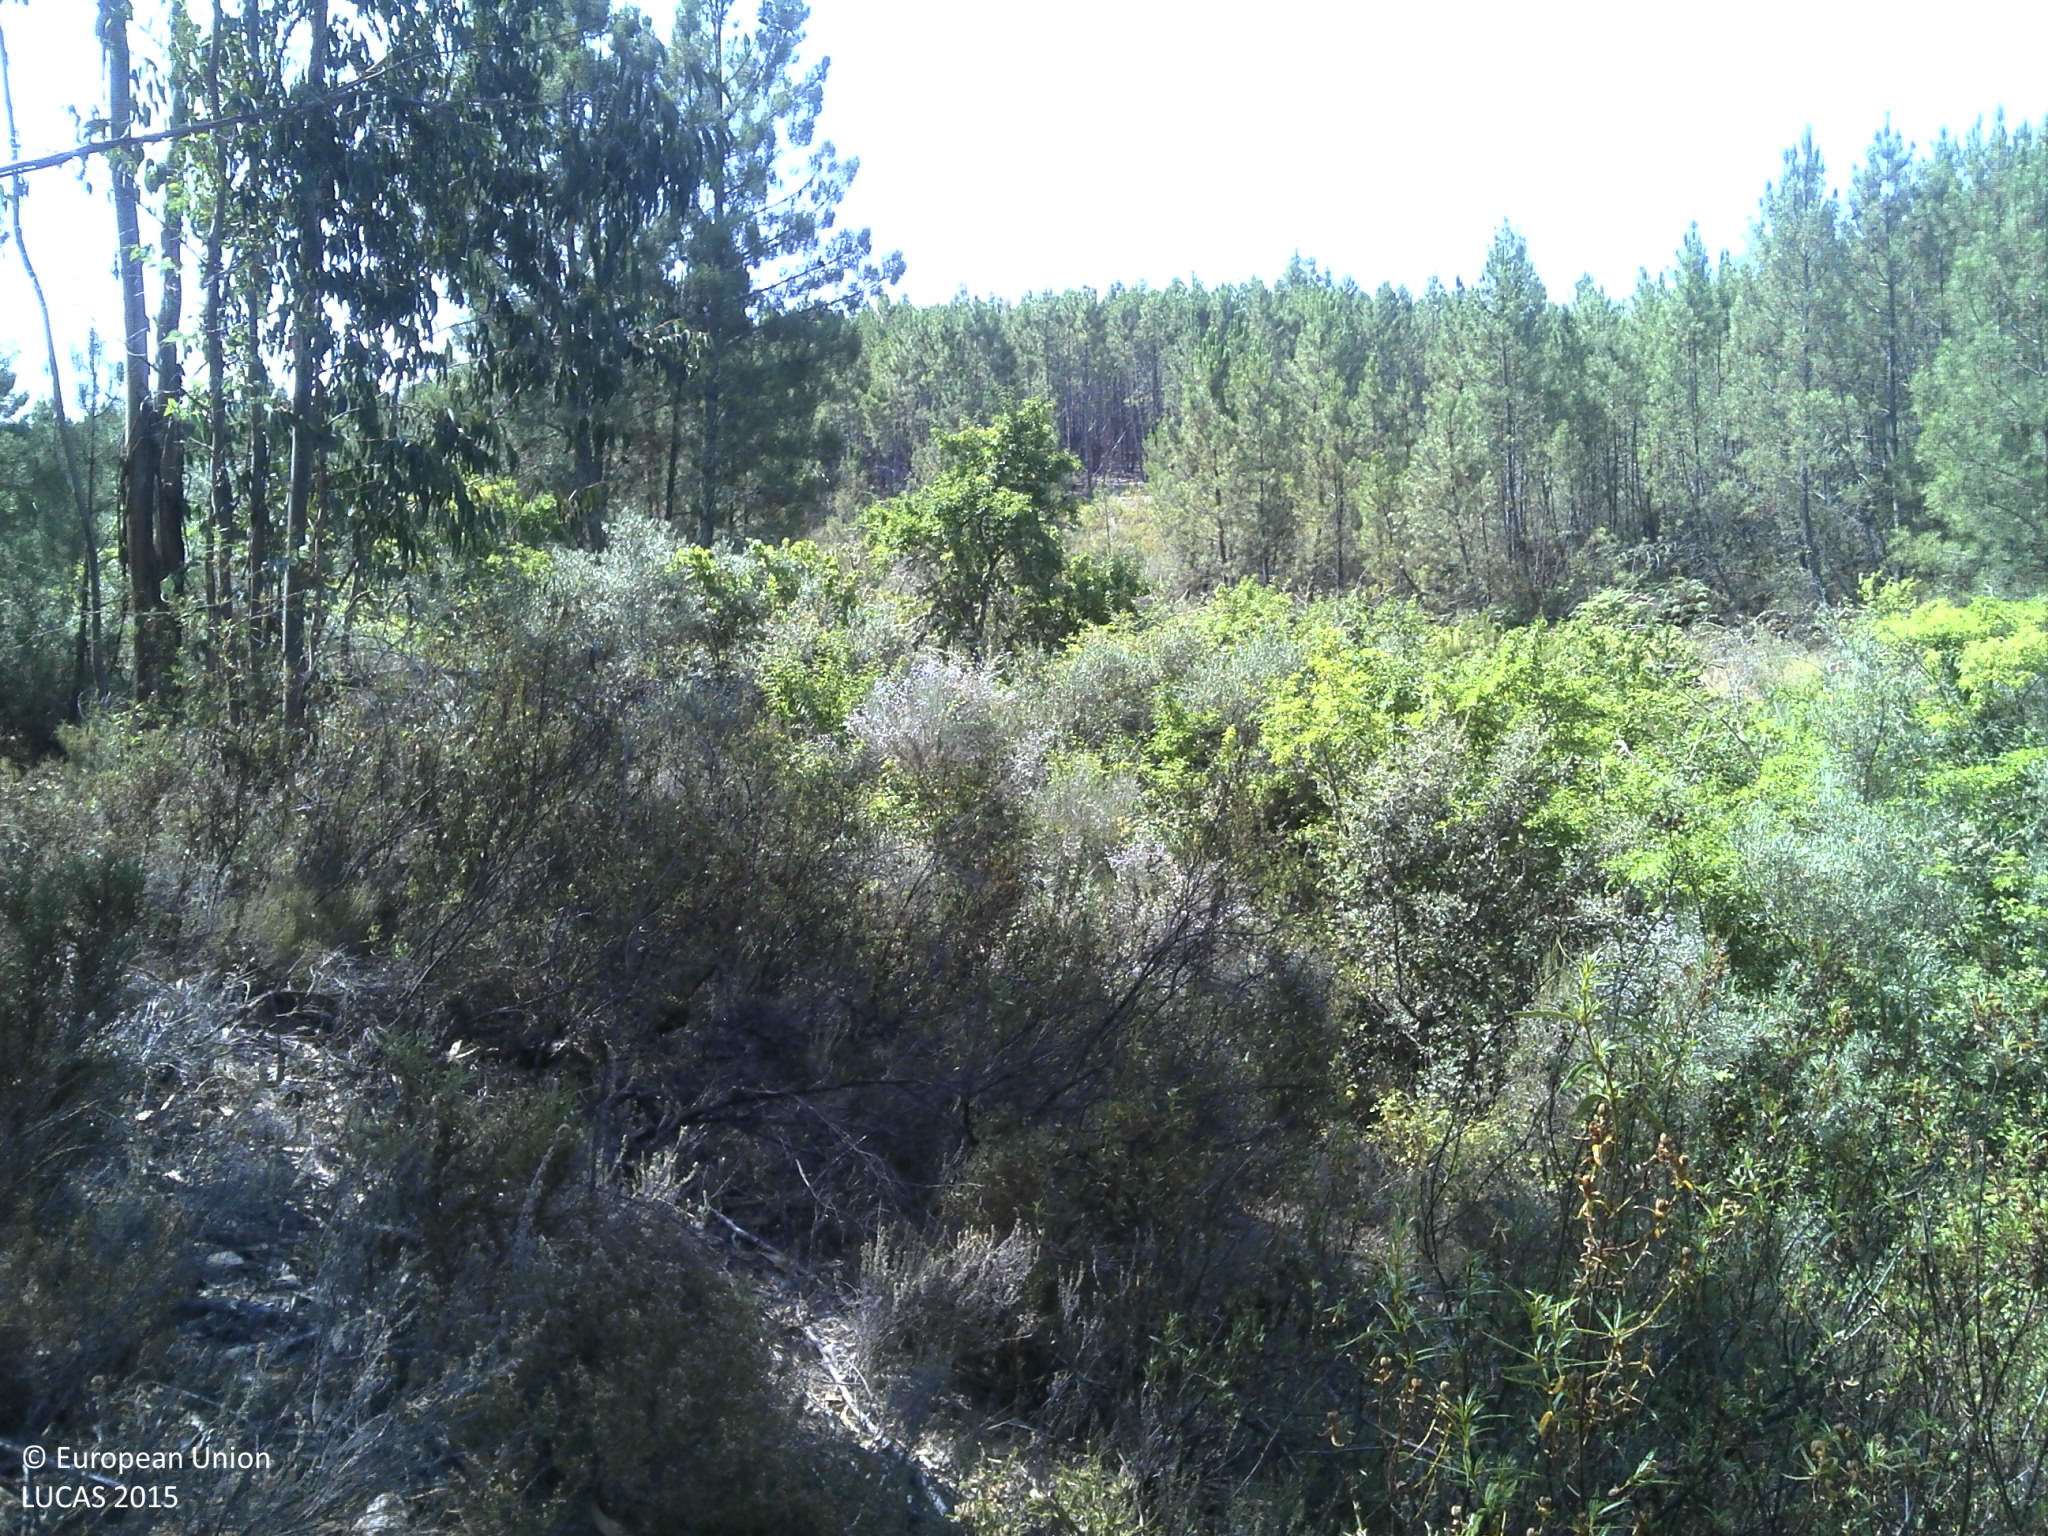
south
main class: Woodland
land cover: Broadleaved woodland
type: exotic forest
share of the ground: 50 - 75 %
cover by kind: broadleaved forest trees 60 %, shrubs 20 %, unconsolidated bare surface 20 %
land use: Forestry
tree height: > 5 m
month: July
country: PT
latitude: 39.7699
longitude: -7.6003
